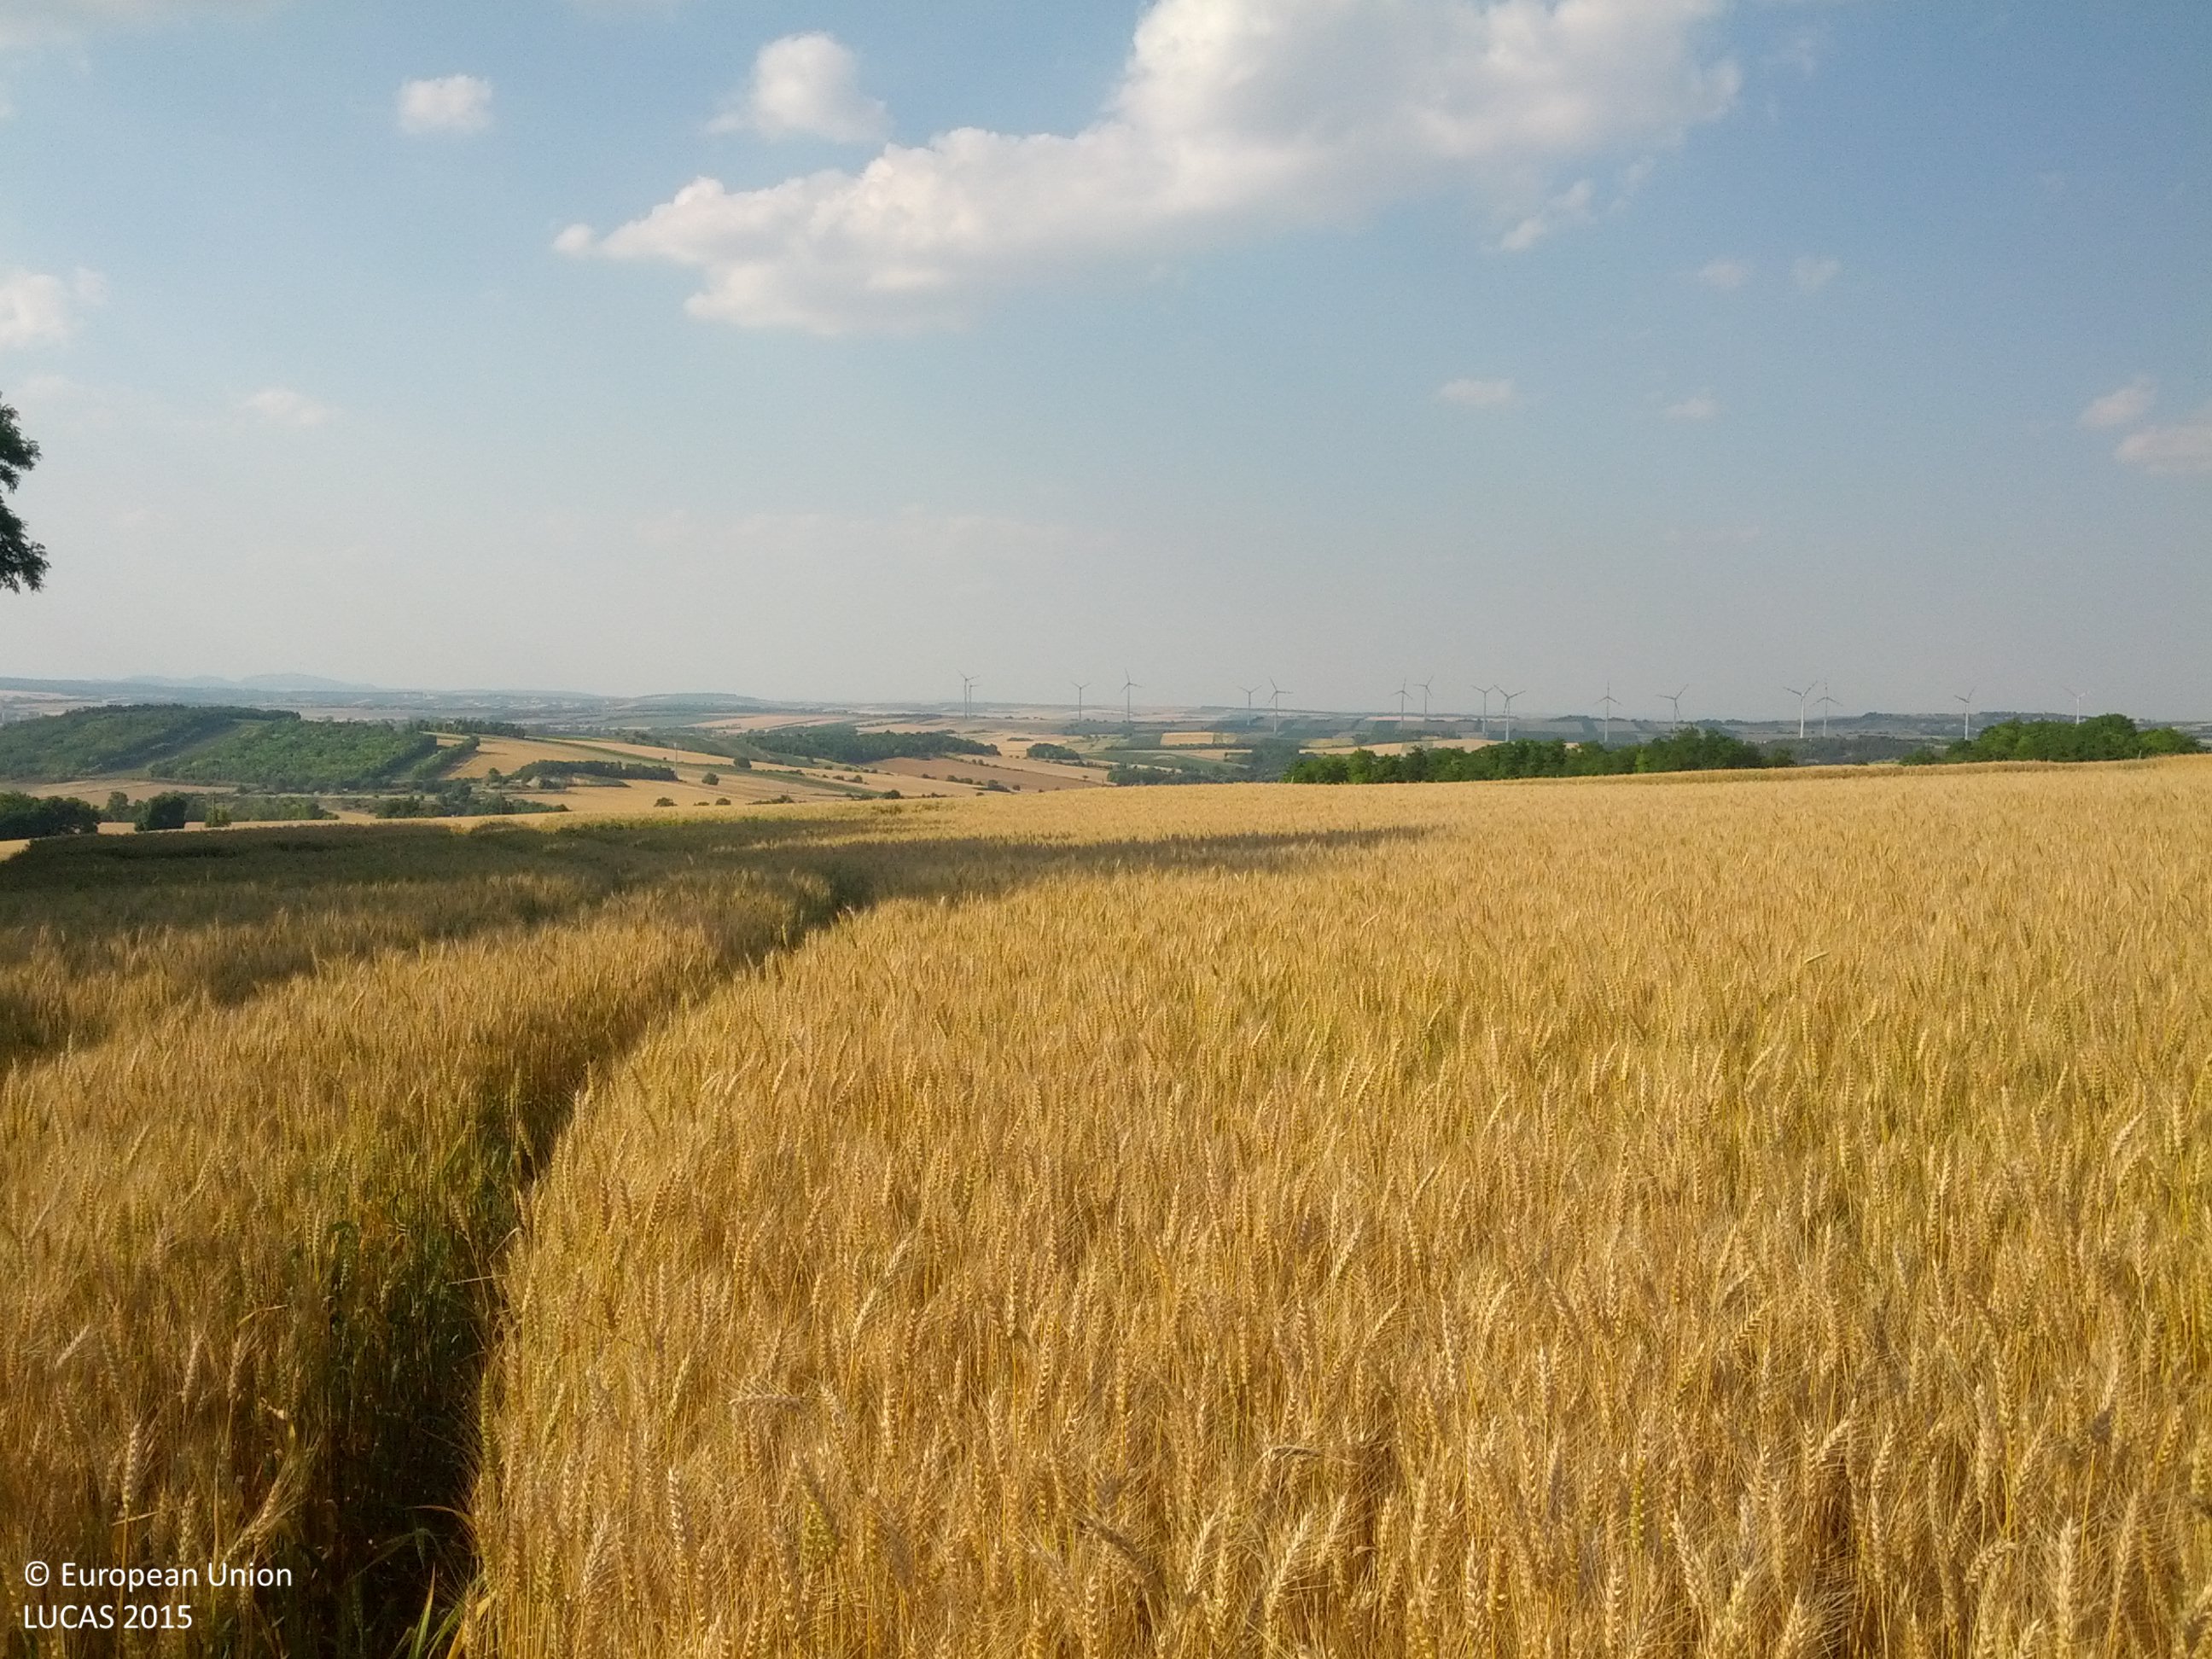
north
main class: Cropland
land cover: Common wheat
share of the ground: > 75 %
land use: Agriculture (excluding fallow land and kitchen gardens)
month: July
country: AT
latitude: 48.5946
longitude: 16.7460
